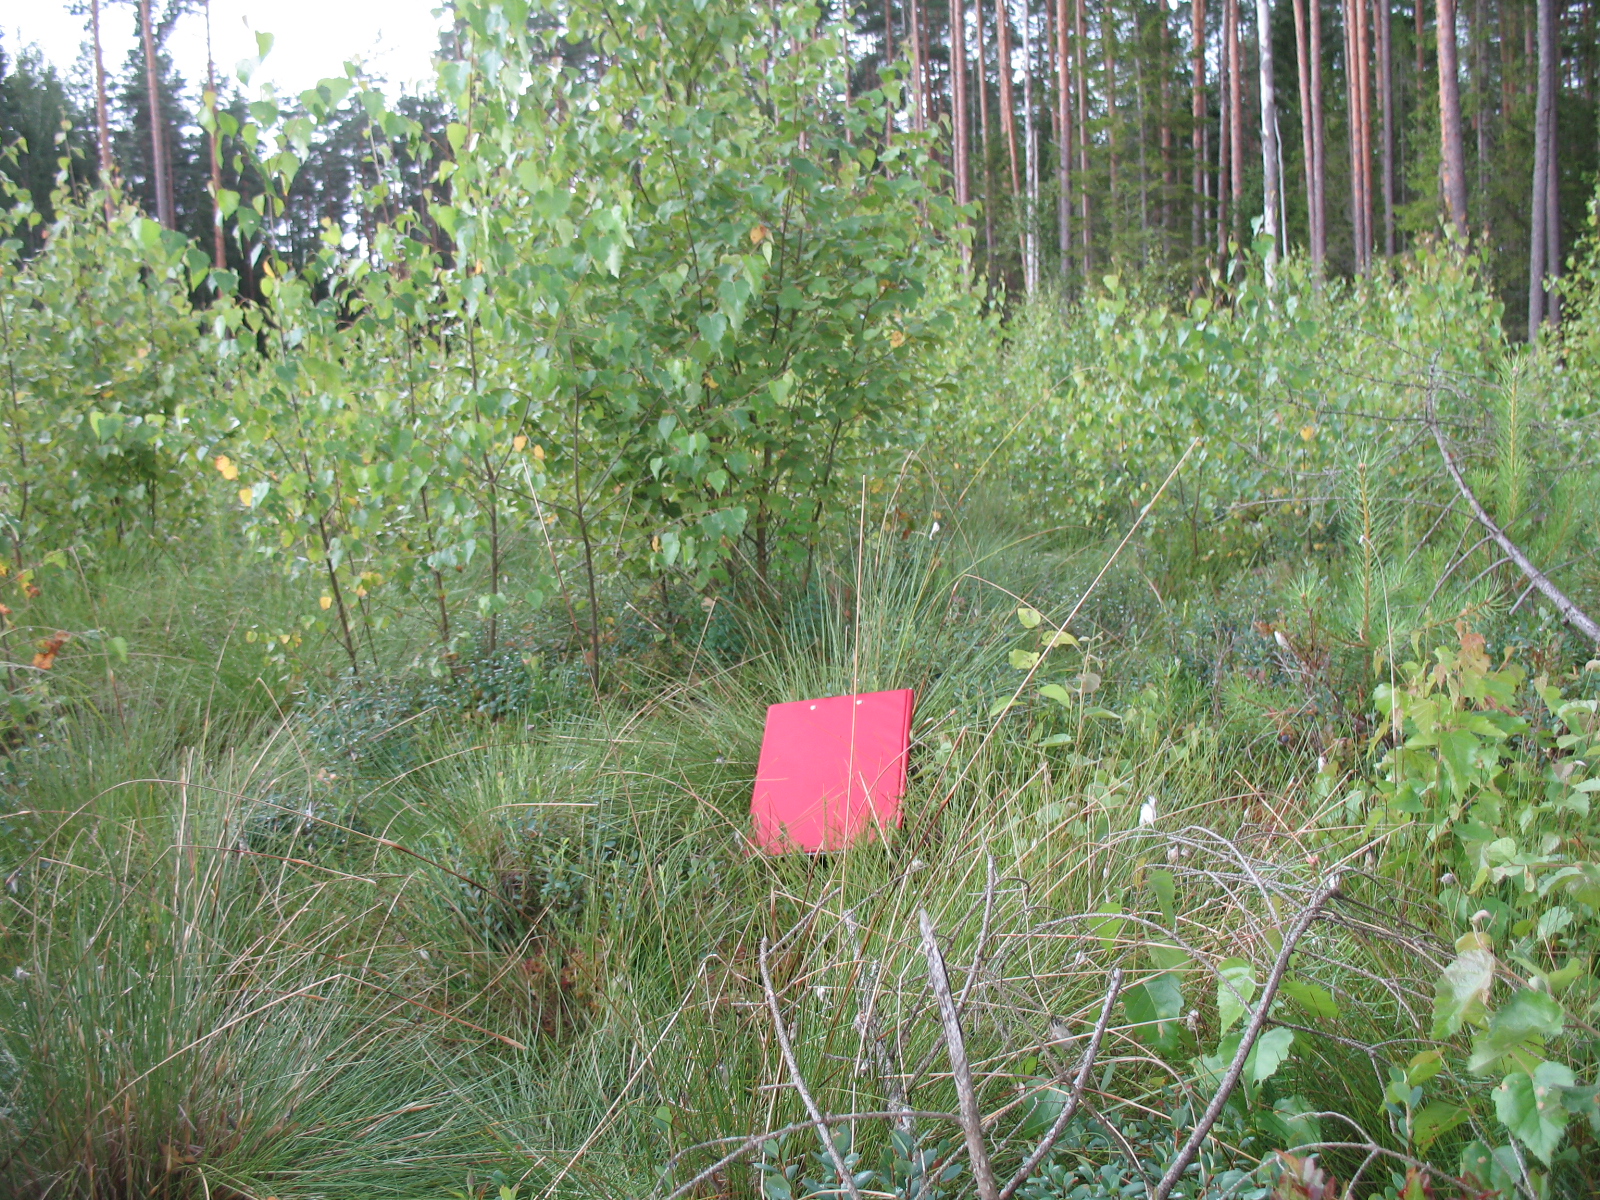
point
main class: Woodland
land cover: Broadleaved woodland
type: mire and swamp forests
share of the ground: 25 - 50 %
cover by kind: herbaceous plants 45 %, broadleaved forest trees 40 %, lichens and mosses 10 %, coniferous forest trees 5 %
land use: Forestry
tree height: < 5 m
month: July
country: LV
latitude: 56.3800
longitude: 25.1564
